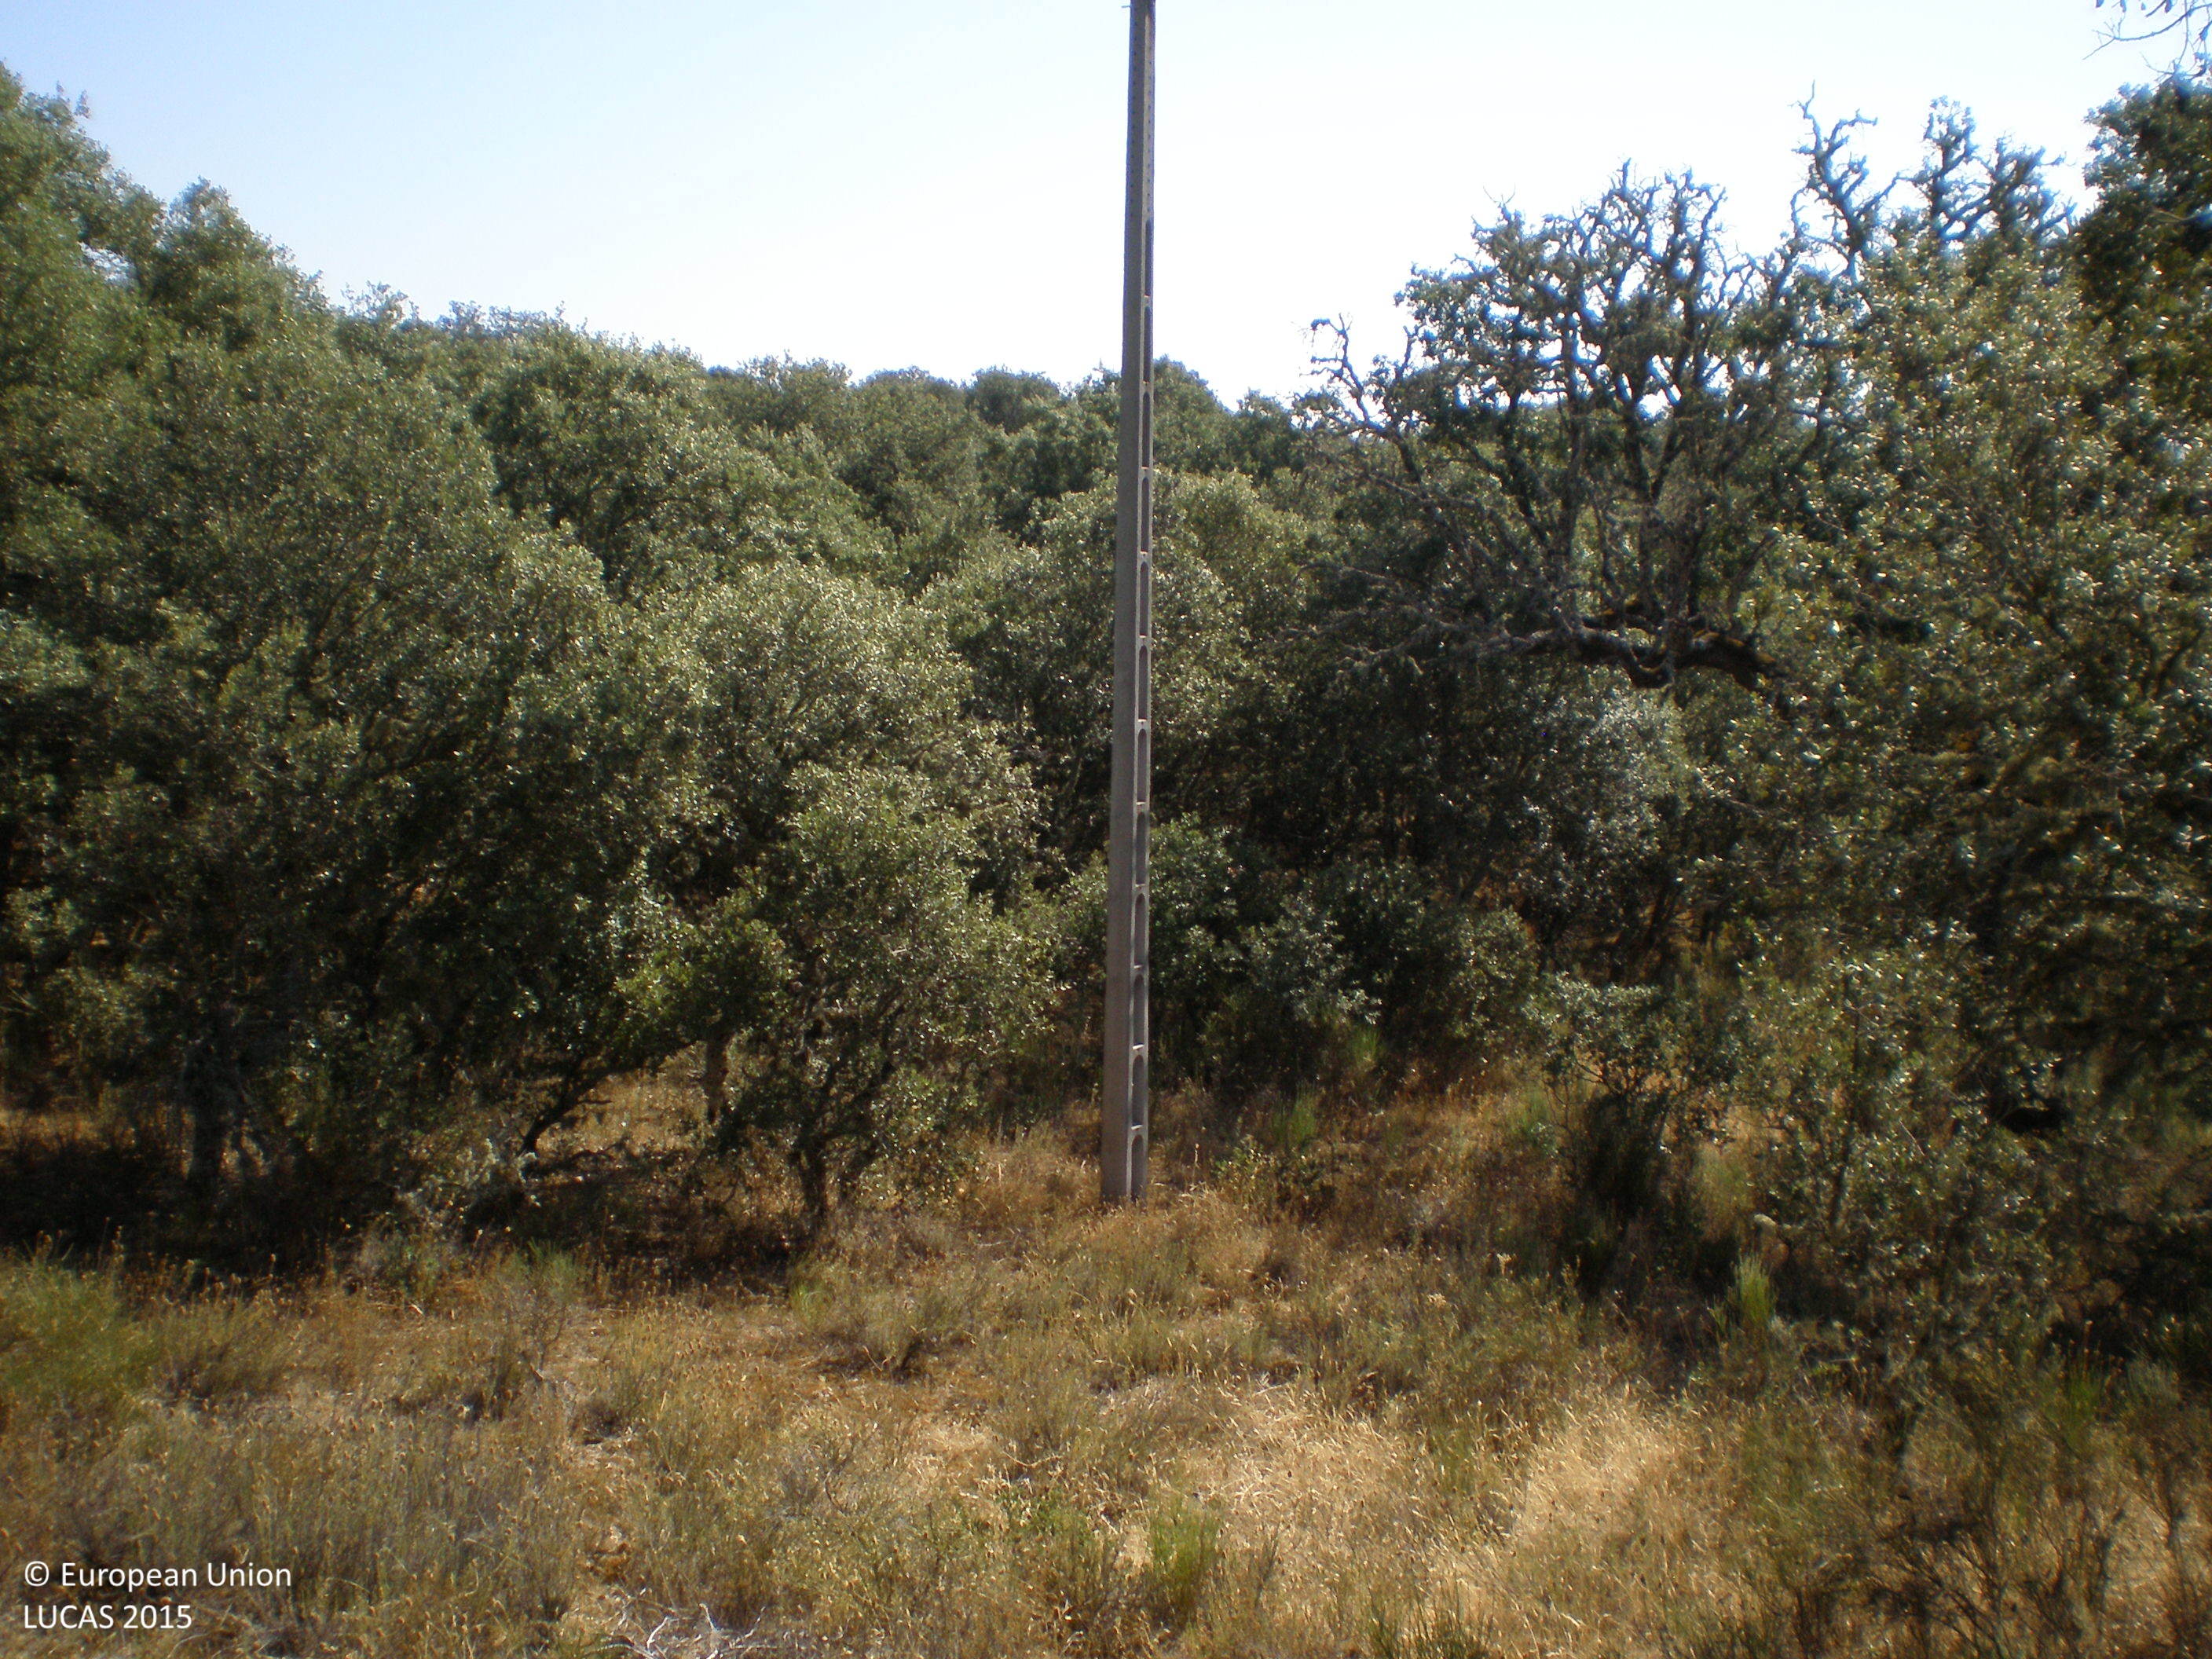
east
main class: Woodland
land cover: Broadleaved woodland
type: broadleaved evergreen forest
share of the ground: 50 - 75 %
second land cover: Grassland without tree/shrub cover
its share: 25 - 50 %
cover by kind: broadleaved forest trees 55 %, herbaceous plants 45 %
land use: Forestry
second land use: Agriculture (excluding fallow land and kitchen gardens)
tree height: > 5 m
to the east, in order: Broadleaved woodland; Grassland without tree/shrub cover; Electric lines; Broadleaved woodland; Grassland with sparse tree/shrub cover; Fences; Grass margins; Tracks; Grass margins; Fences; Grassland with sparse tree/shrub cover; Broadleaved woodland
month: July
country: ES
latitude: 40.4685
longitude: -5.7942
